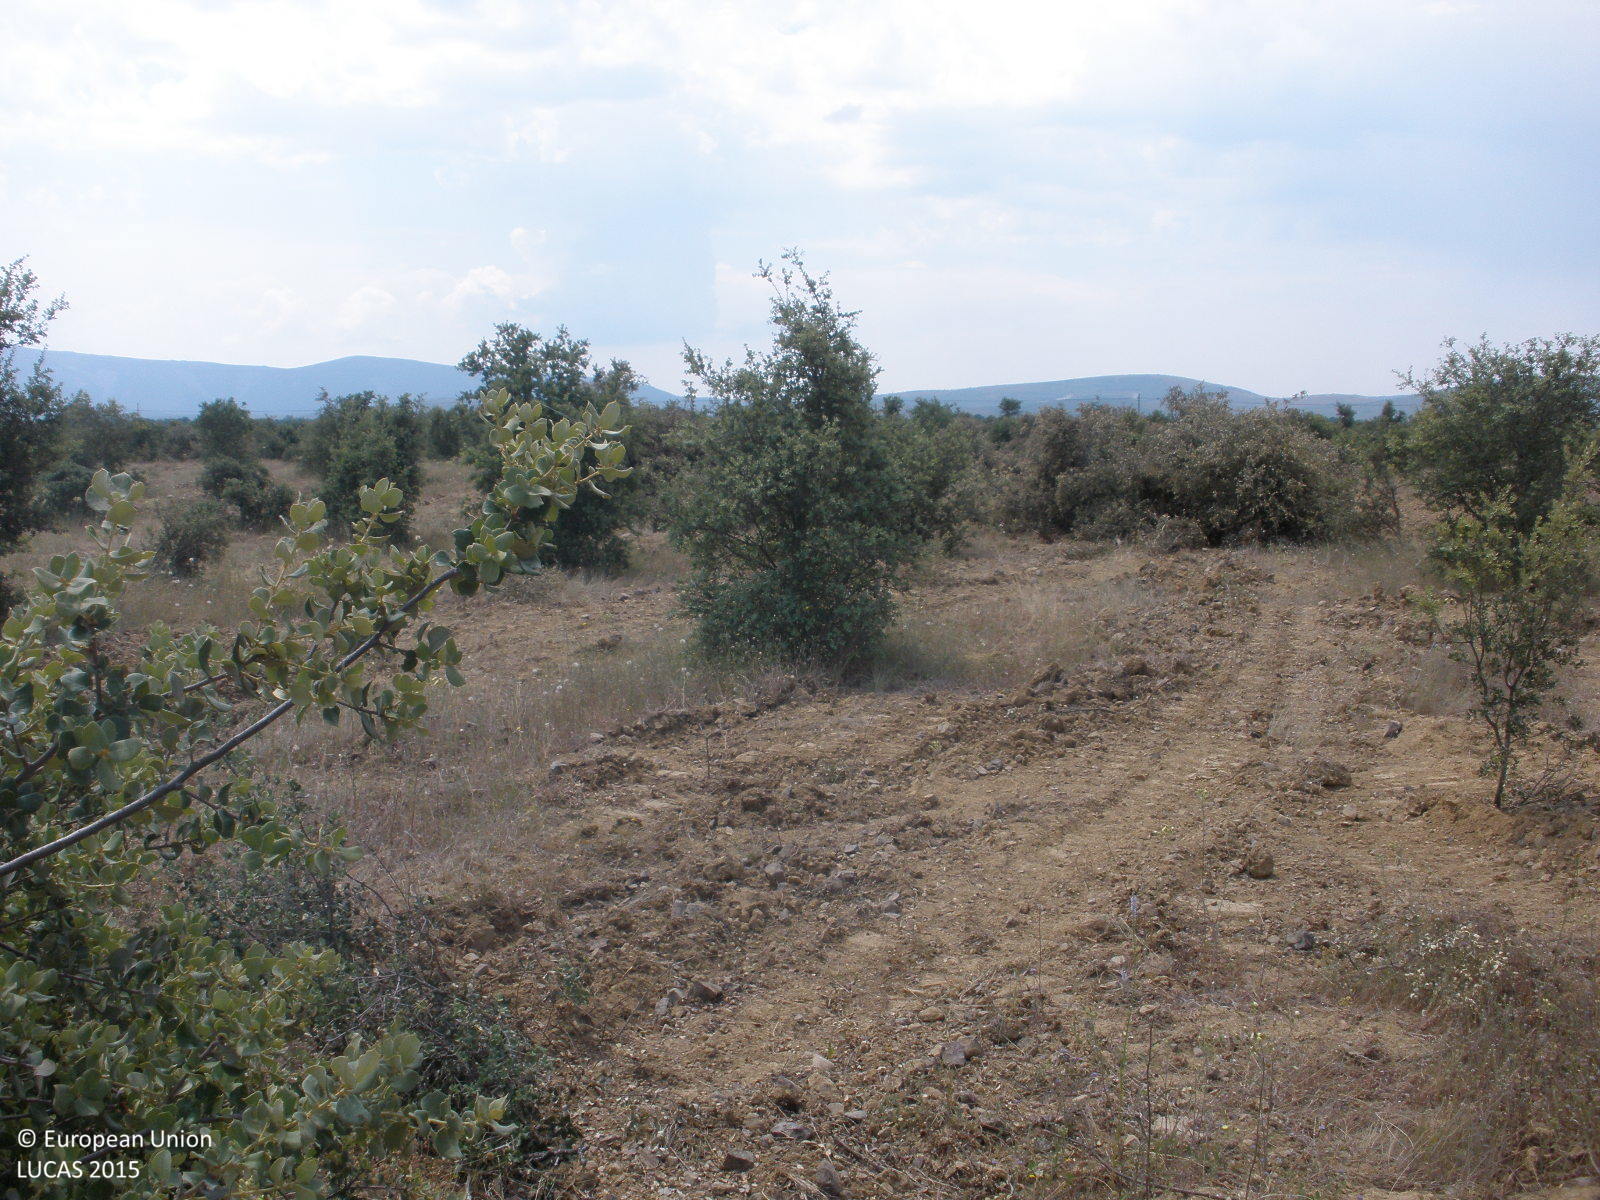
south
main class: Woodland
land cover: Broadleaved woodland
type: broadleaved evergreen forest
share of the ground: 50 - 75 %
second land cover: Spontaneously vegetated surfaces
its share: 25 - 50 %
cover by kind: broadleaved forest trees 50 %, unconsolidated bare surface 40 %, herbaceous plants 10 %
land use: Forestry
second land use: Fallow land
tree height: < 5 m
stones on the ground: > 50 %
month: June
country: ES
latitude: 40.6078
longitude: -6.2881
